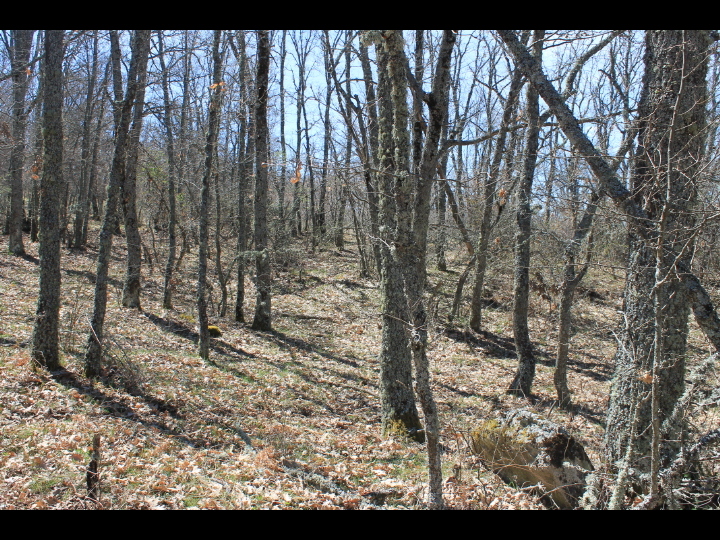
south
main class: Woodland
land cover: Broadleaved woodland
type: thermophilous deciduous forest
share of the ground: > 75 %
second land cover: Grassland without tree/shrub cover
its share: 10 - 25 %
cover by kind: broadleaved forest trees 90 %, herbaceous plants 5 %, lichens and mosses 5 %
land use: Forestry
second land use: Agriculture (excluding fallow land and kitchen gardens)
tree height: > 5 m
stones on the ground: < 10 %
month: April
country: ES
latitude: 40.9076
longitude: -3.9975
